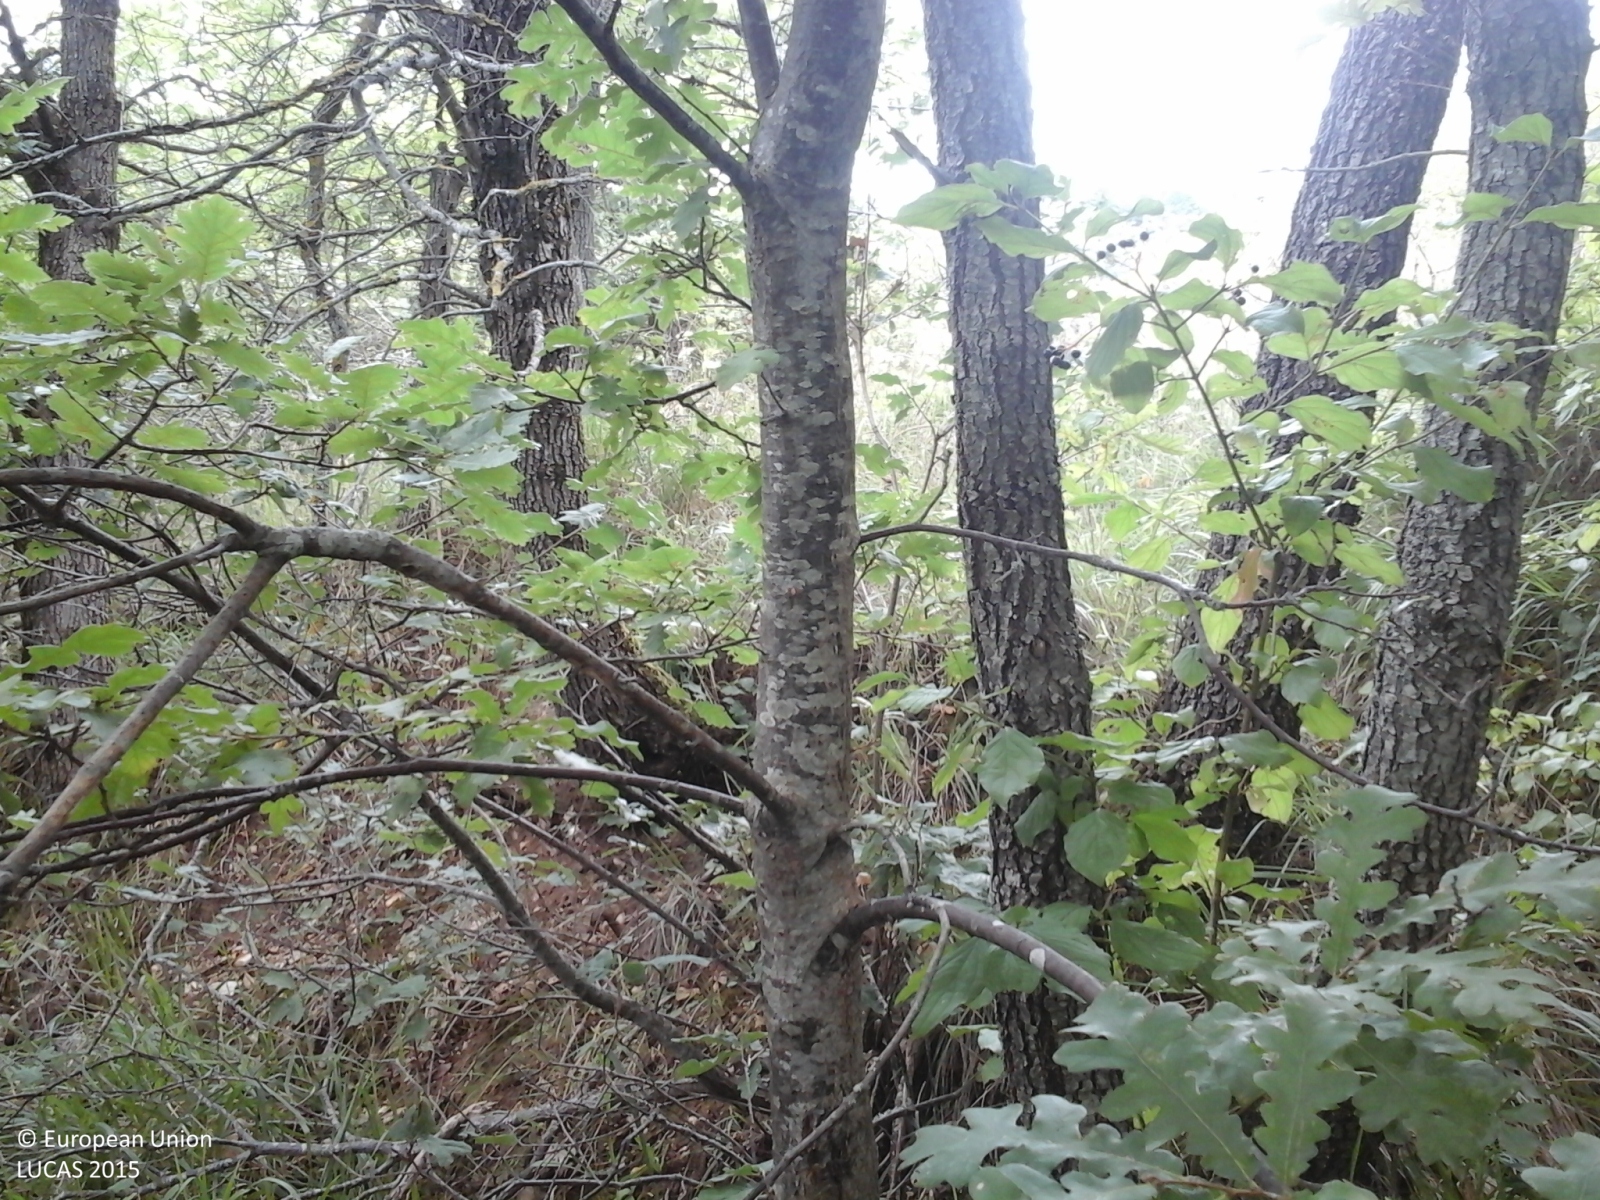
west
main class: Woodland
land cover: Broadleaved woodland
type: thermophilous deciduous forest
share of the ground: 50 - 75 %
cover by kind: broadleaved forest trees 95 %, coniferous forest trees 5 %
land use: Forestry
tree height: > 5 m
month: August
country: IT
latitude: 43.4040
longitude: 13.0174
